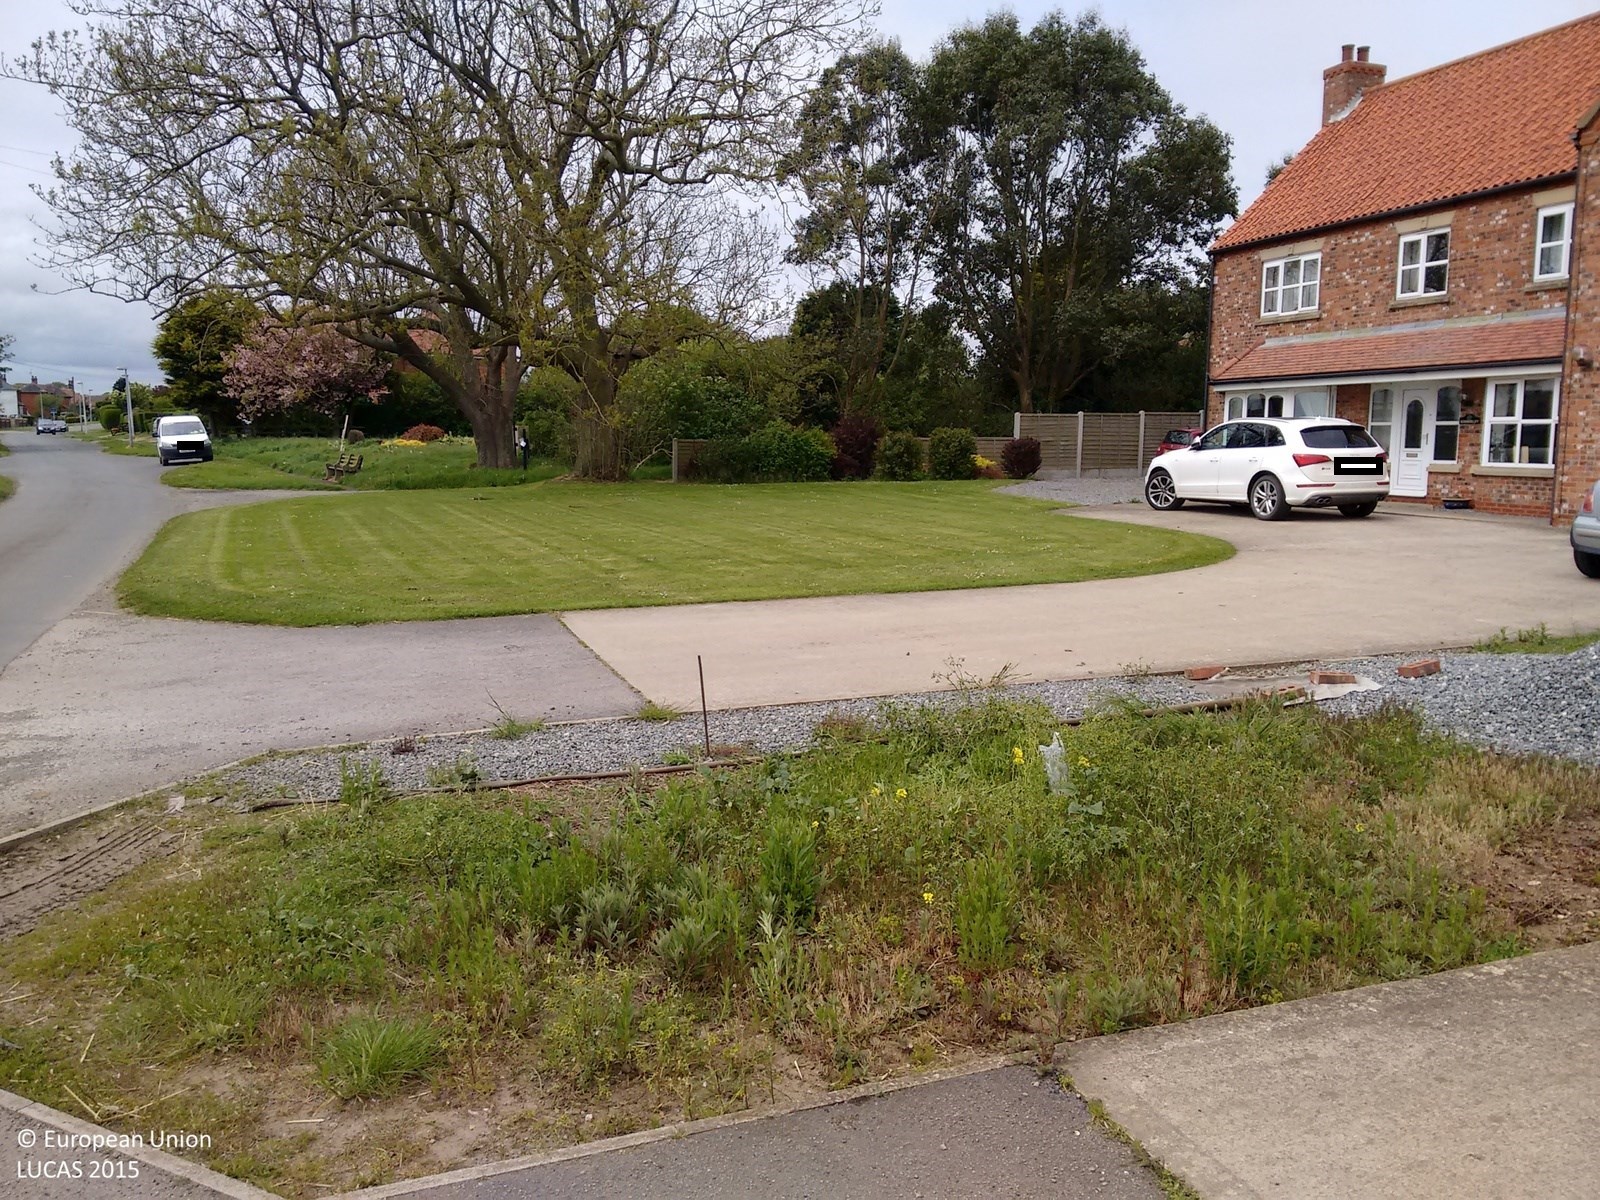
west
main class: Grassland
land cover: Grassland without tree/shrub cover
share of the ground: > 75 %
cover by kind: herbaceous plants 100 %
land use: Residential
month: May
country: GB
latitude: 53.8299
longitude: -0.1058
